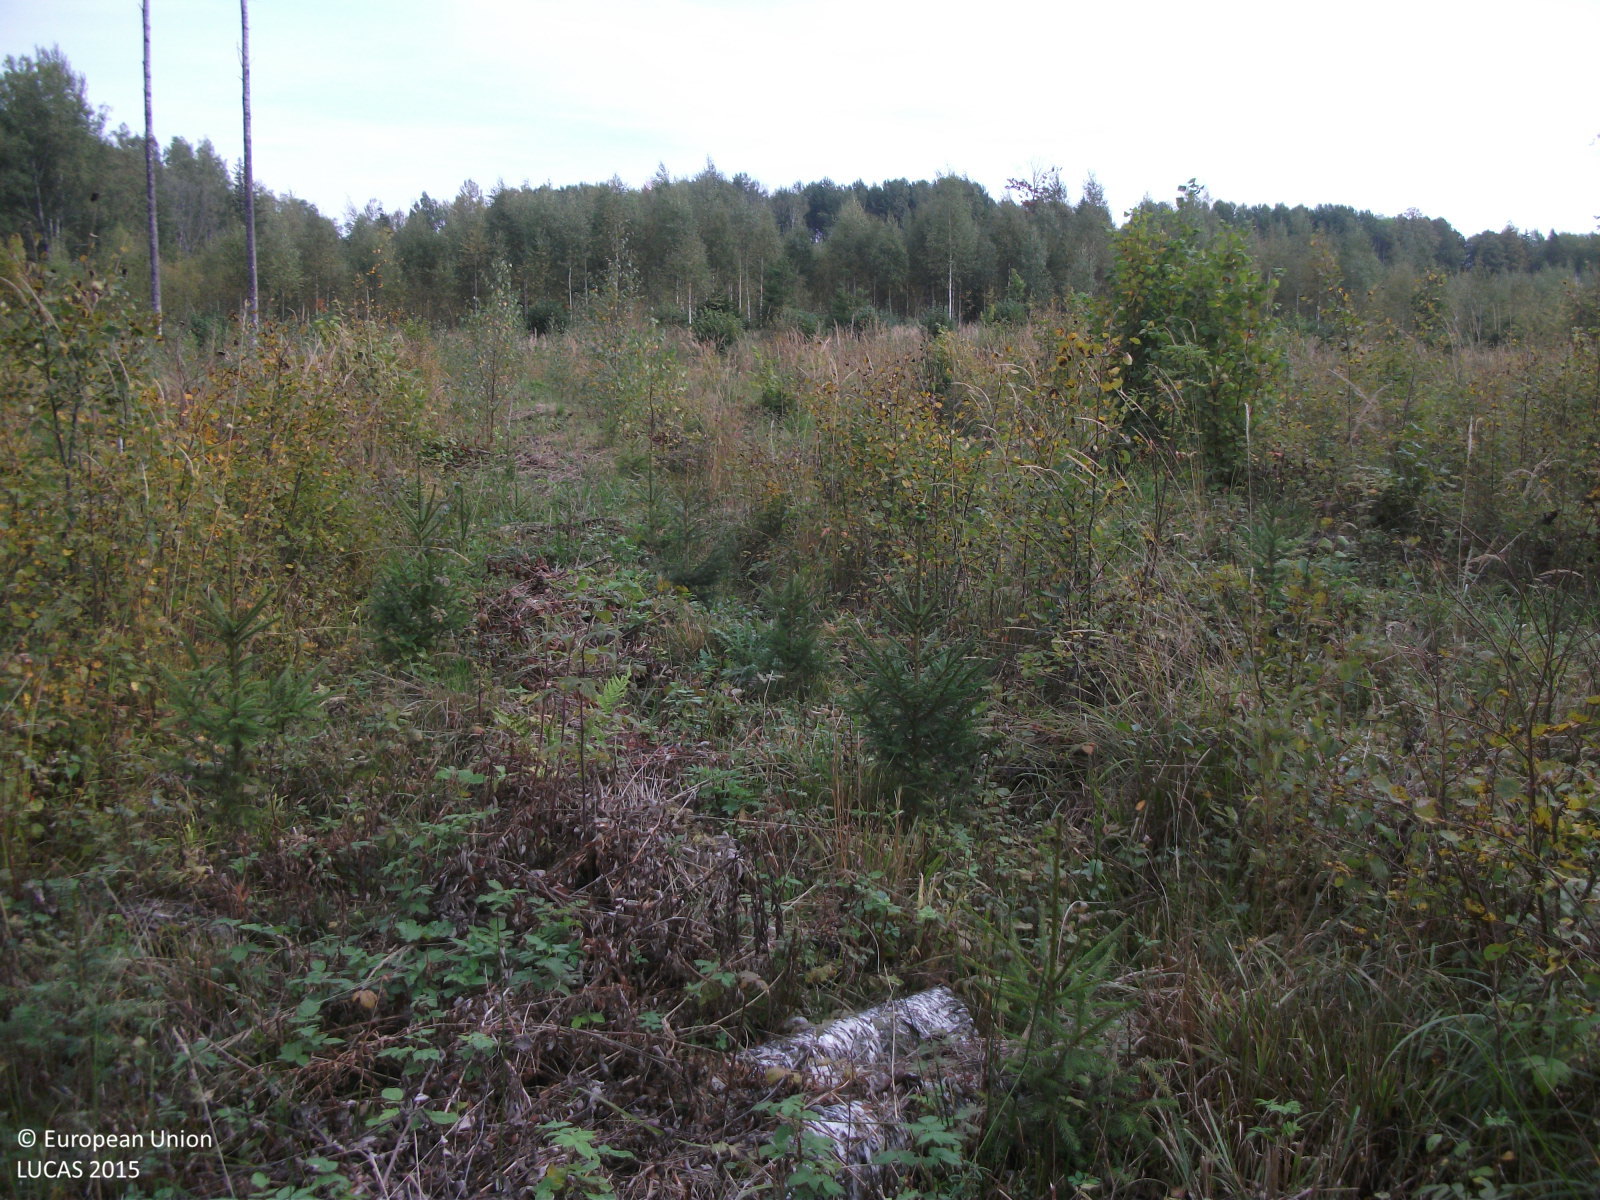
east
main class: Grassland
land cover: Grassland with sparse tree/shrub cover
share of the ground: > 75 %
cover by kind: herbaceous plants 90 %, coniferous forest trees 5 %, shrubs 5 %
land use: Forestry
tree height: < 5 m
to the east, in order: Grassland with sparse tree/shrub cover; Broadleaved woodland; Ditches and canals; Broadleaved woodland
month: September
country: LV
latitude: 57.6519
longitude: 24.6211
